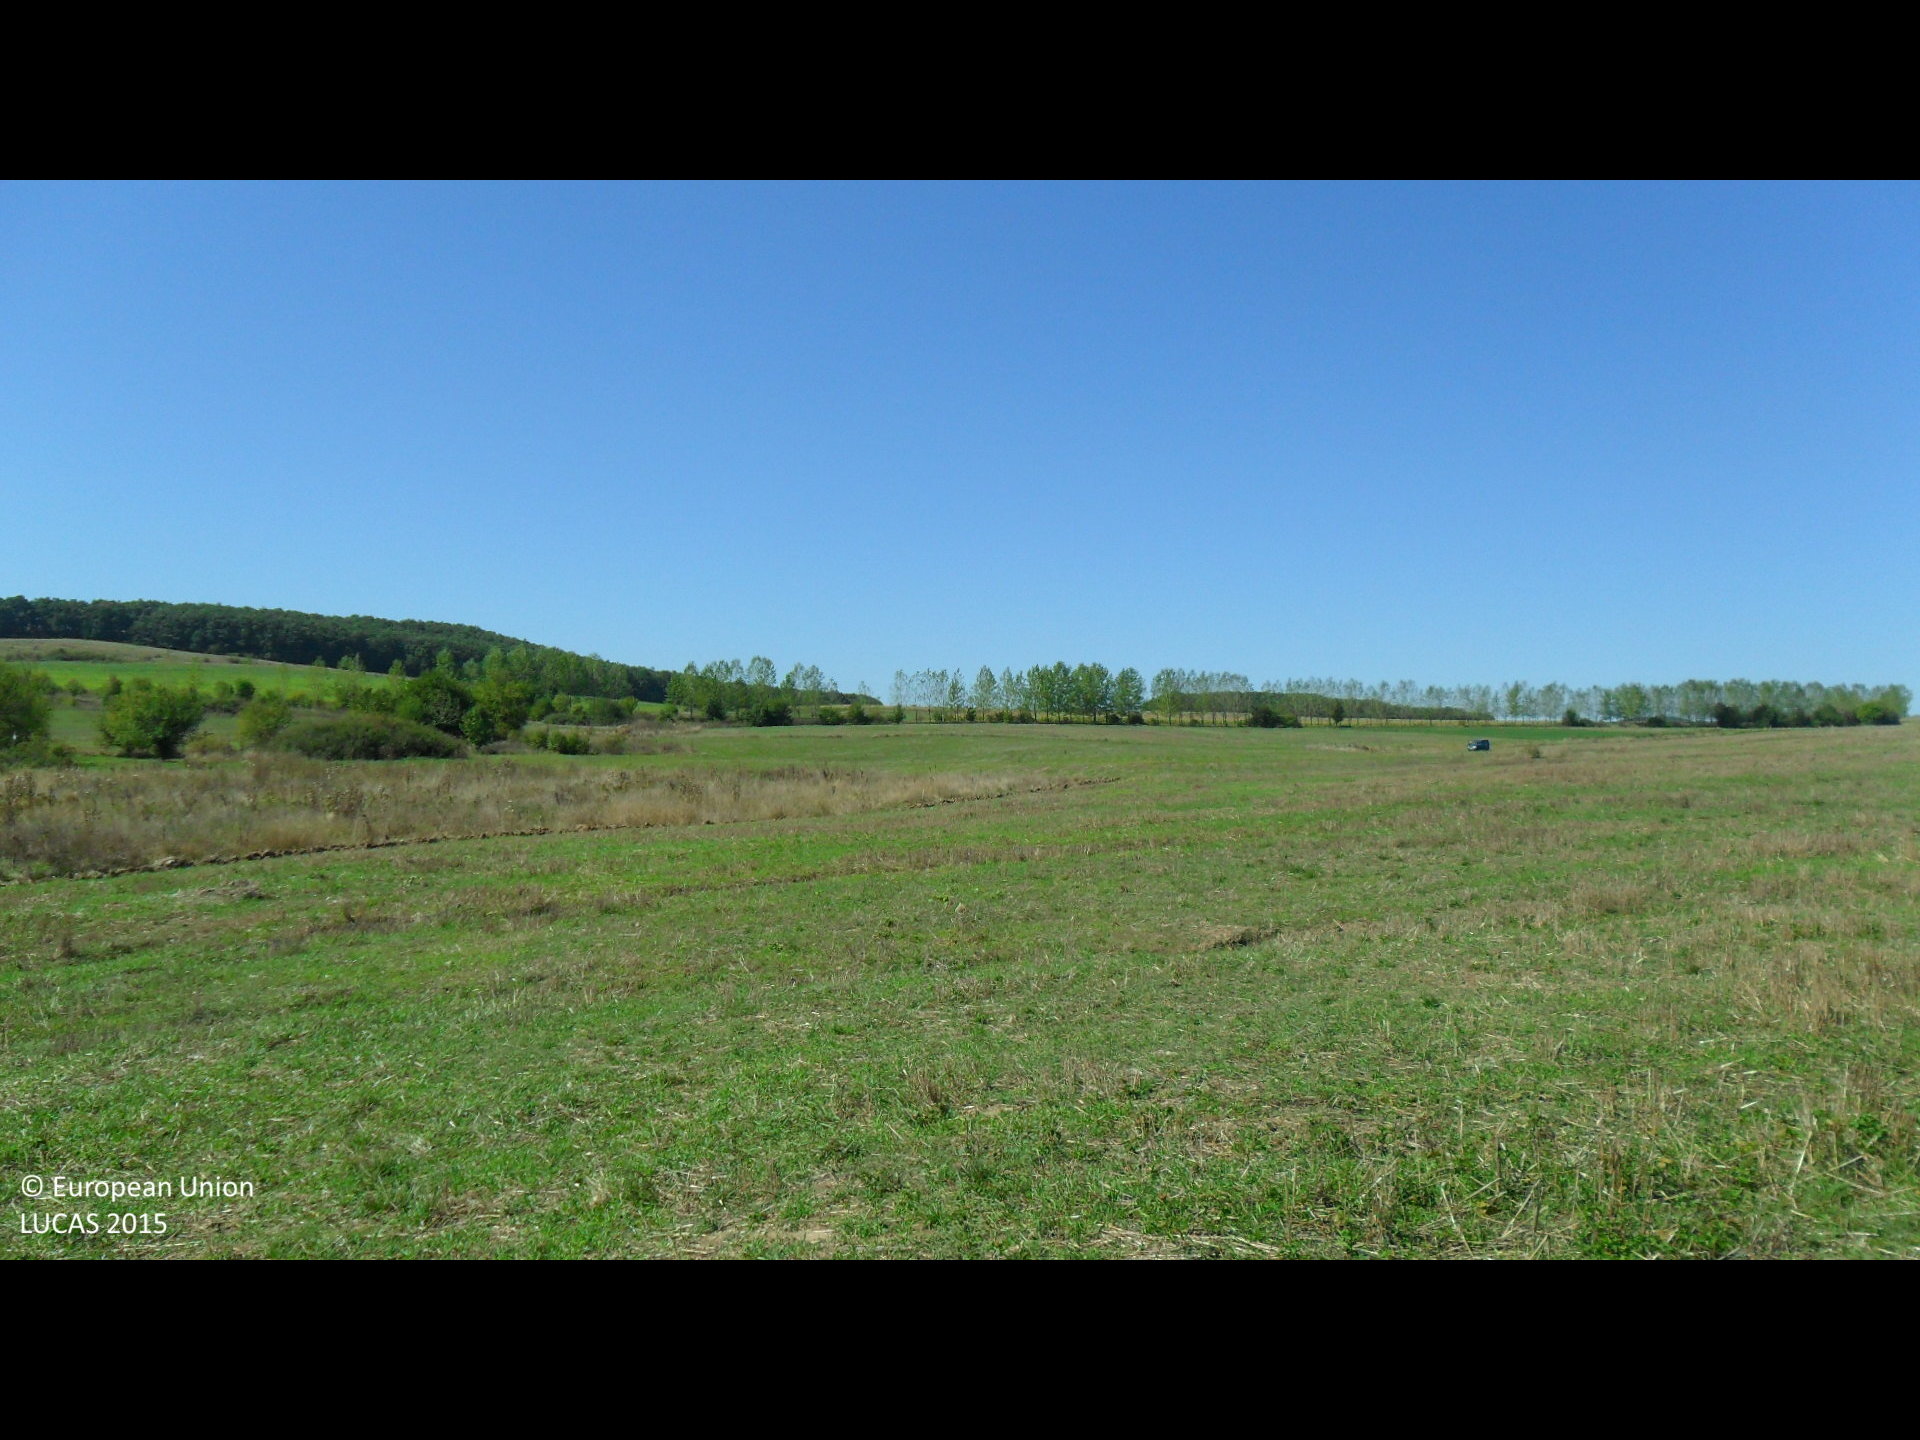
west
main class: Cropland
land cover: Barley
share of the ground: < 10 %
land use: Agriculture (excluding fallow land and kitchen gardens)
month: September
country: BG
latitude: 43.0842
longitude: 26.5484
